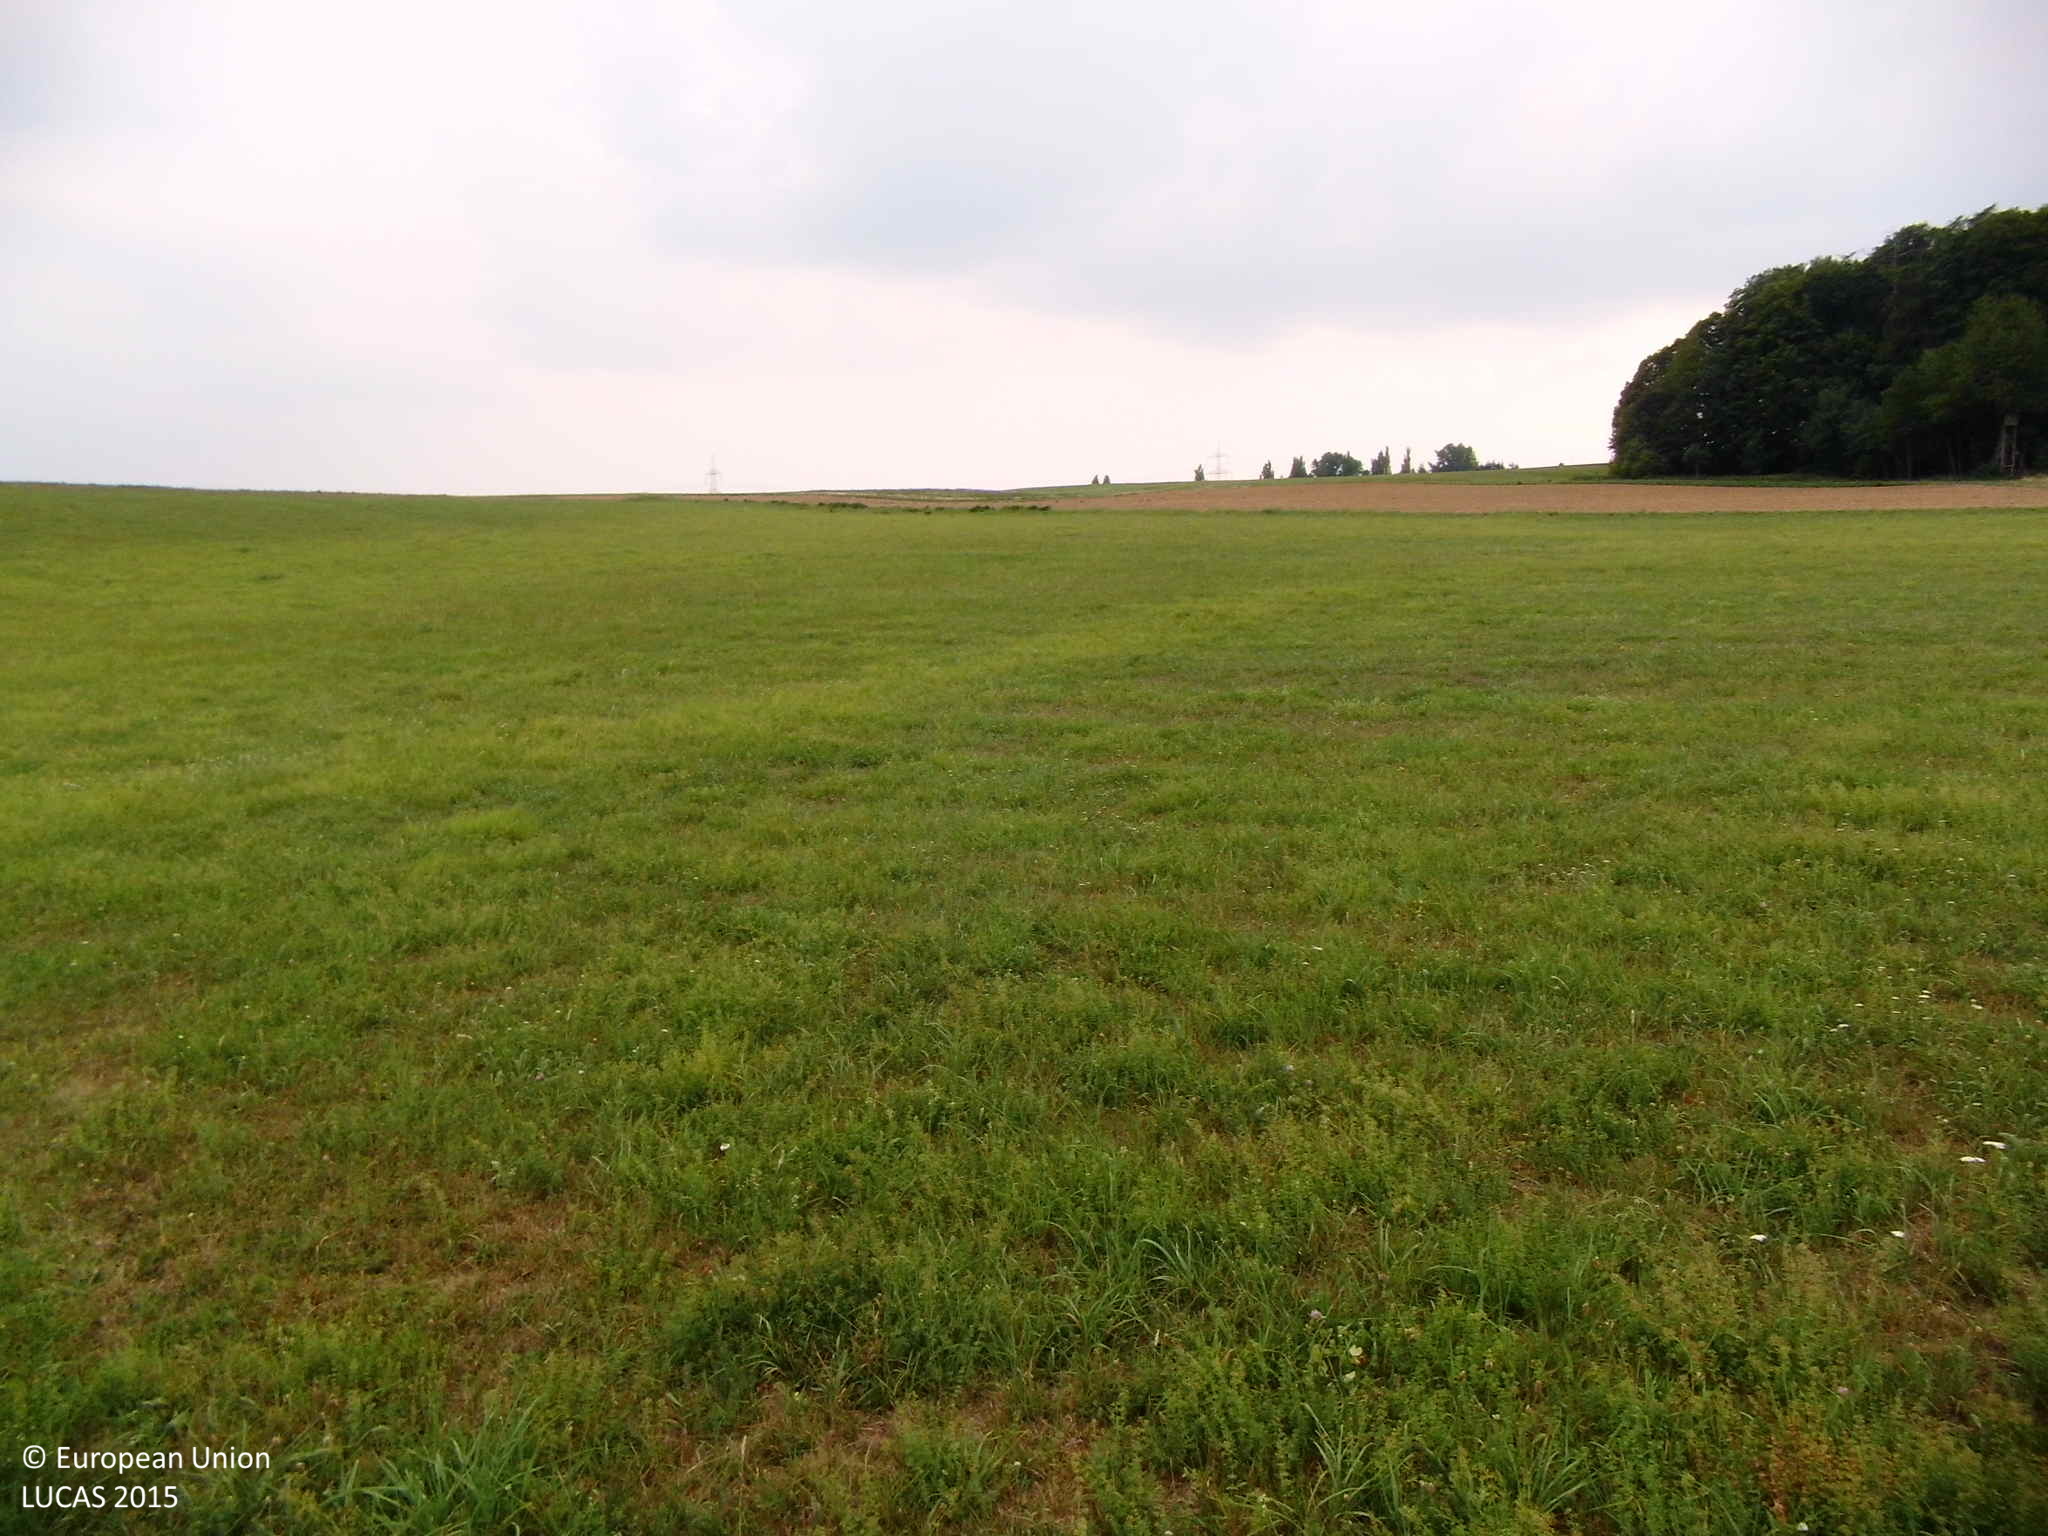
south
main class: Grassland
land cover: Grassland without tree/shrub cover
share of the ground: > 75 %
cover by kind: herbaceous plants 100 %
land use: Agriculture (excluding fallow land and kitchen gardens)
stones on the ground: < 10 %
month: August
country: DE
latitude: 50.6073
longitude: 8.6014
